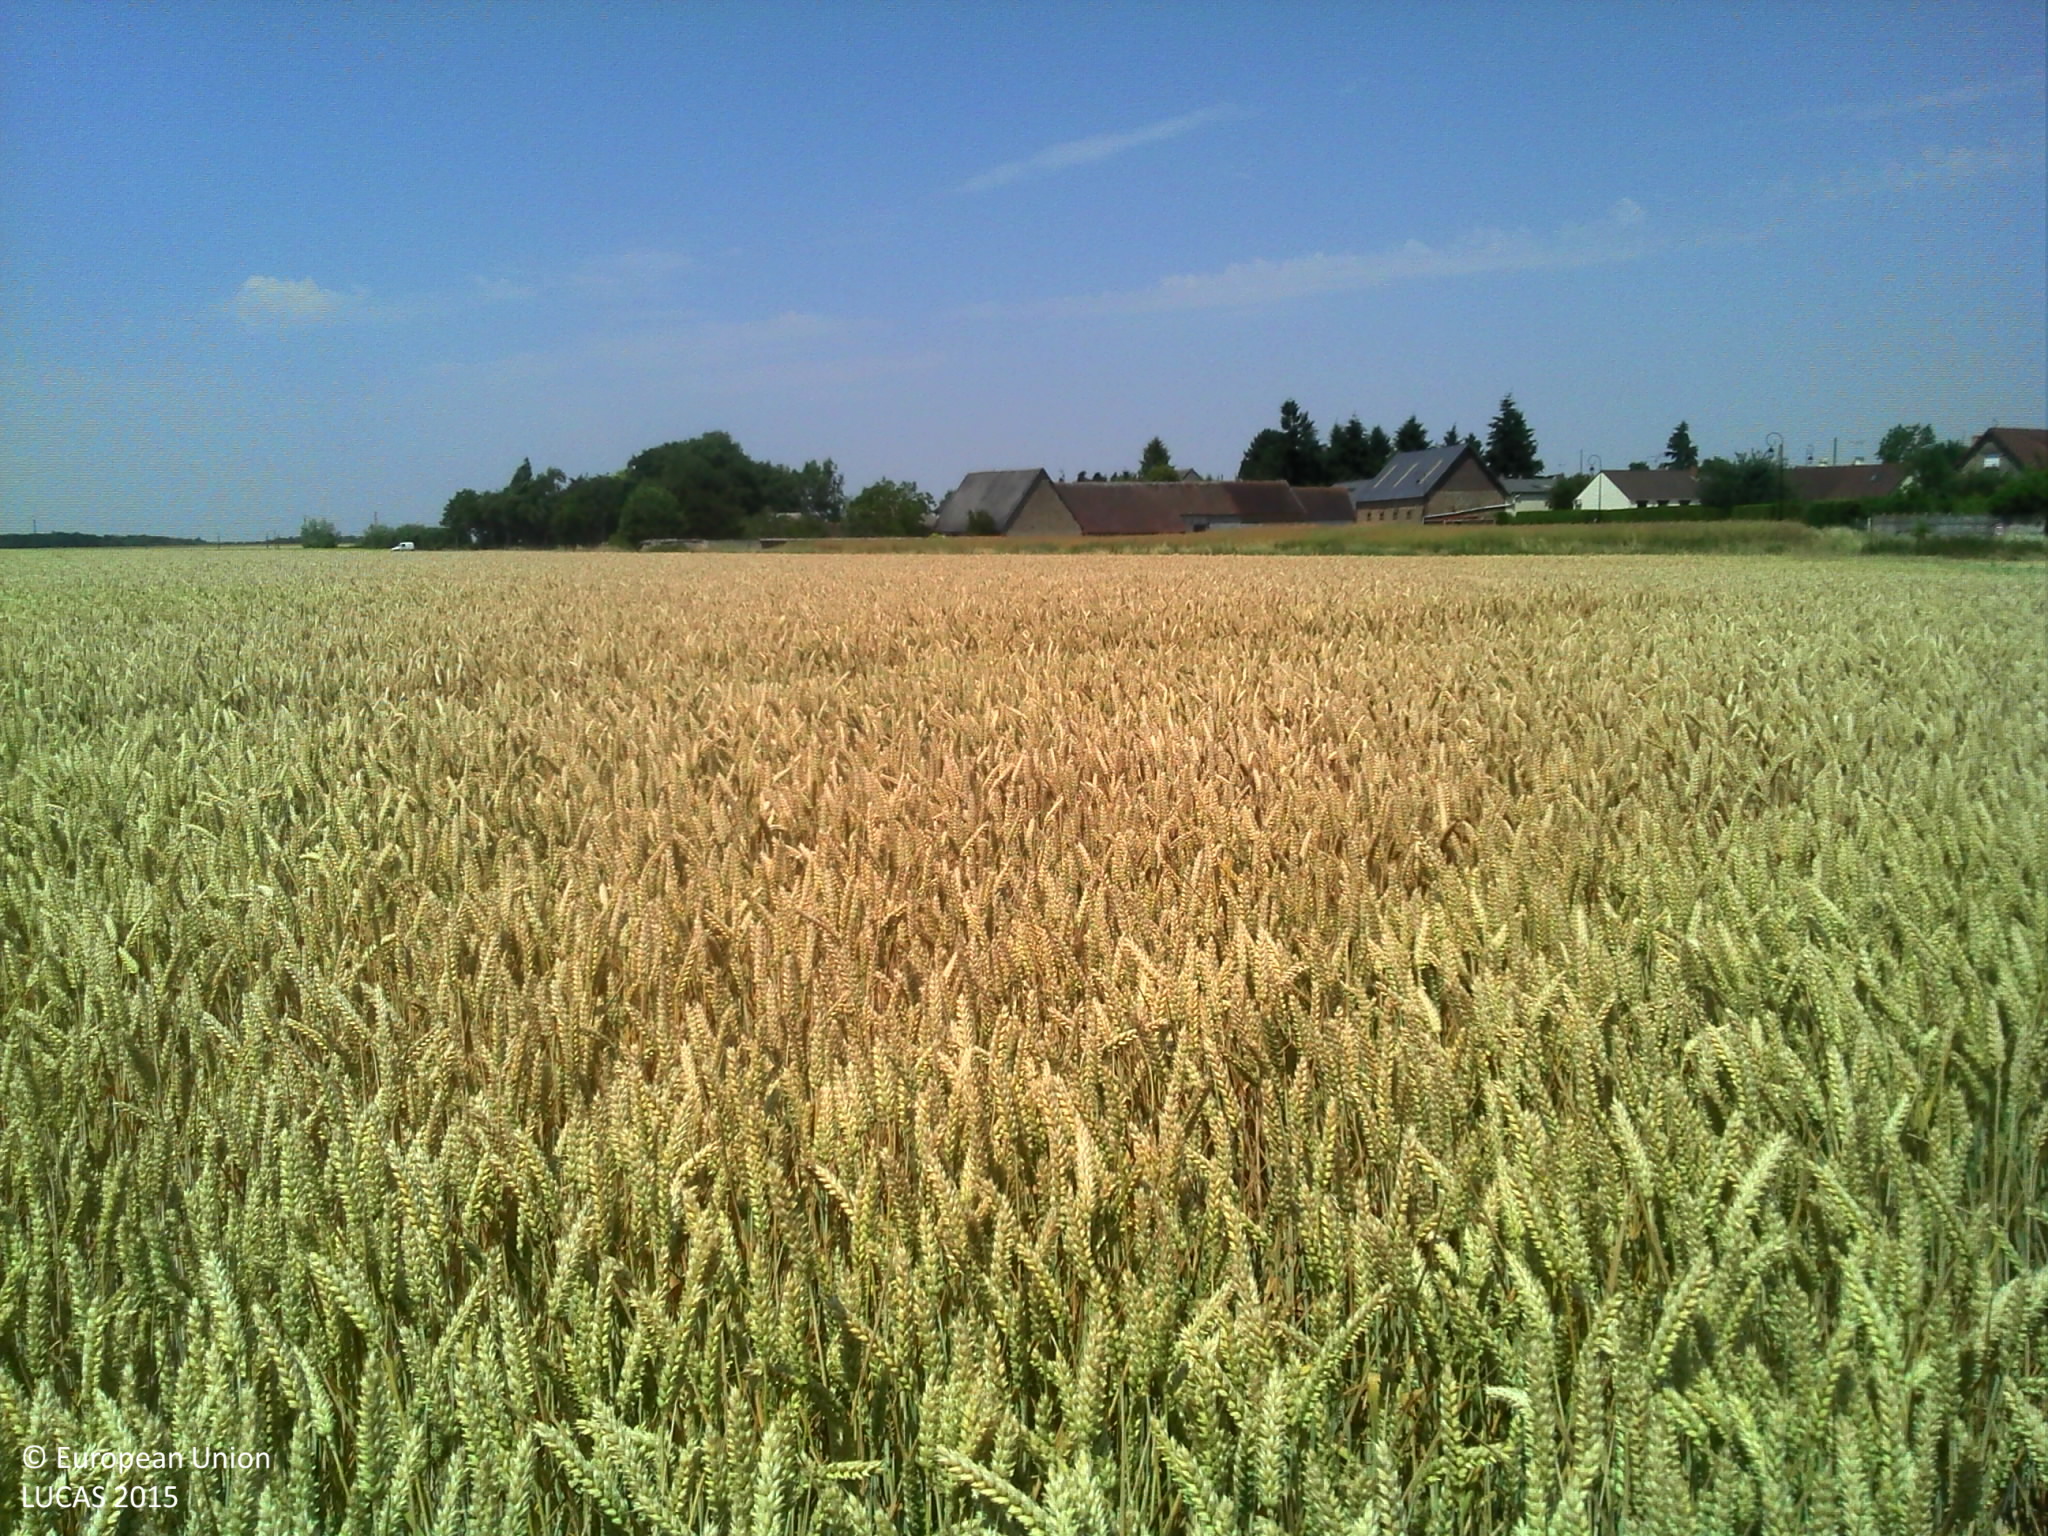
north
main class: Cropland
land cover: Common wheat
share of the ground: > 75 %
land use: Agriculture (excluding fallow land and kitchen gardens)
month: July
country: FR
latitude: 48.9454
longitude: 1.2832
